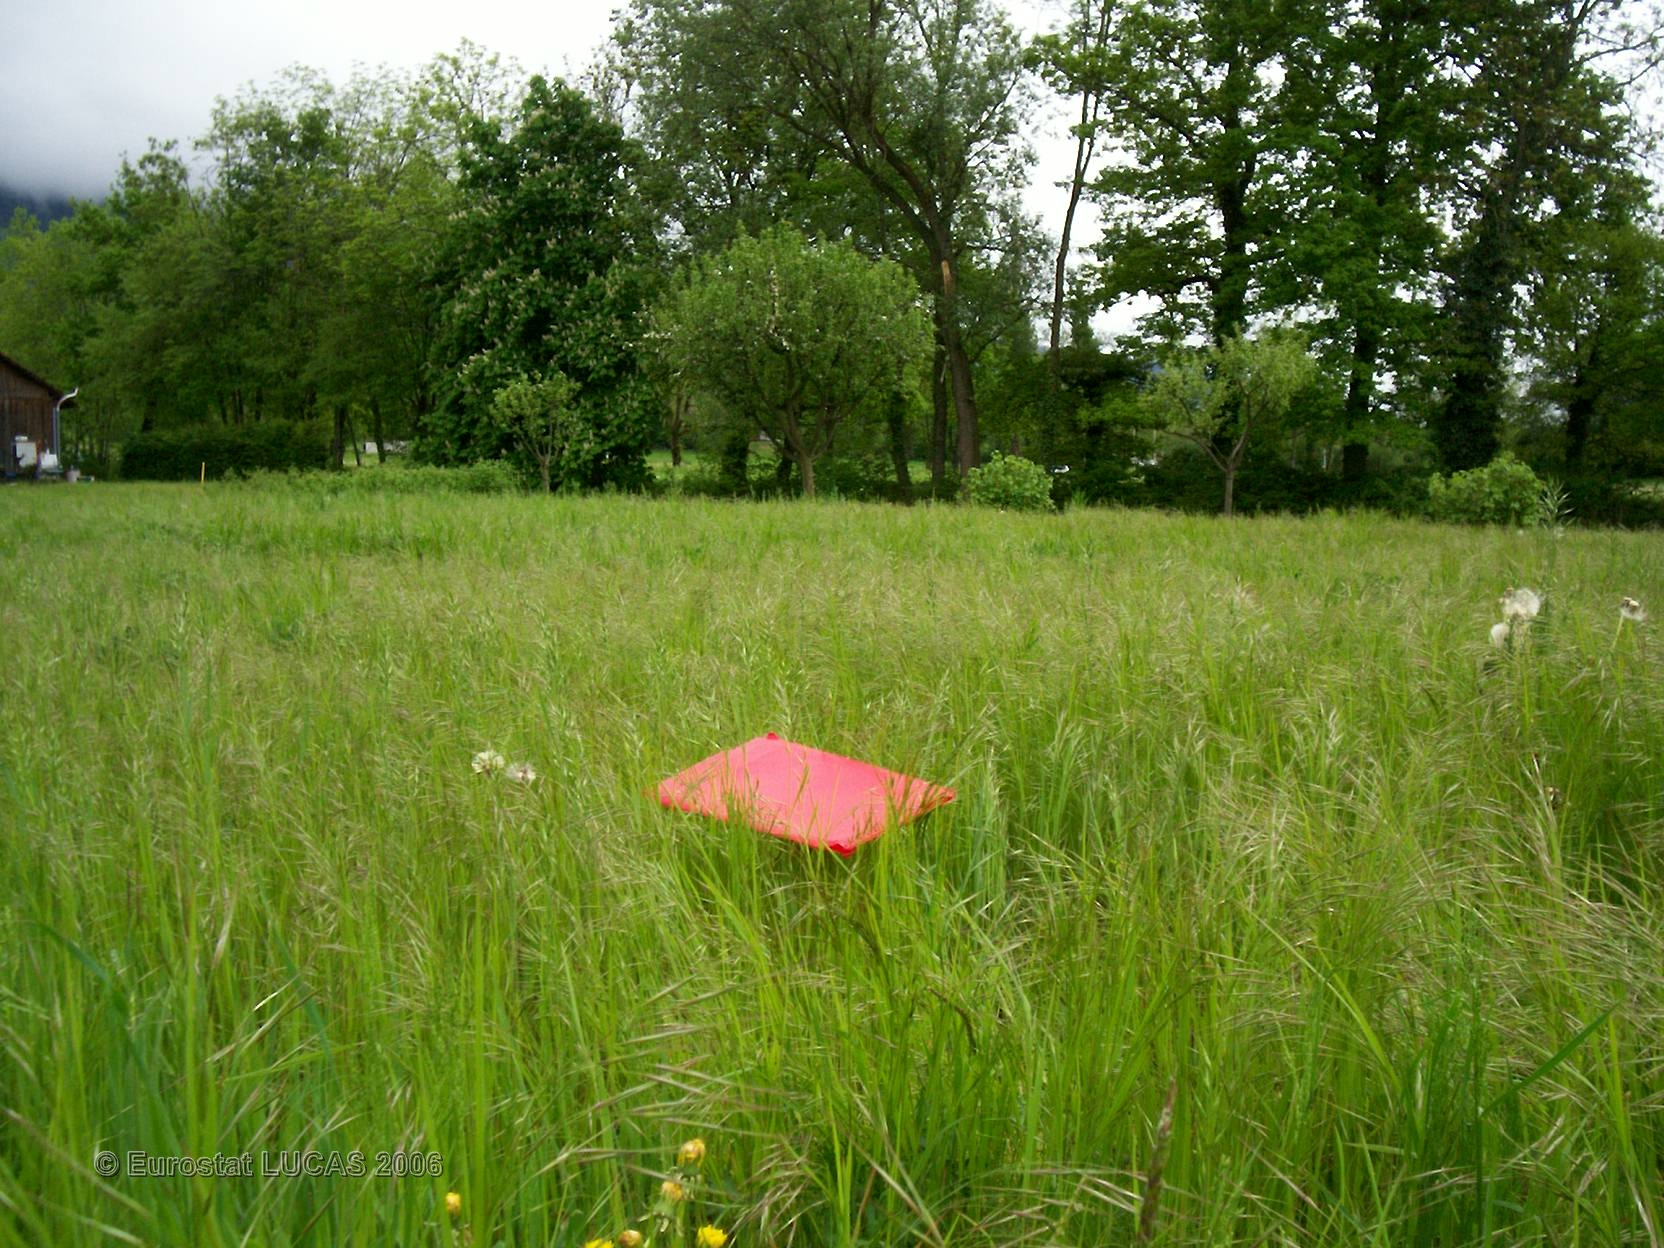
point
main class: Grassland
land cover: Grassland without tree/shrub cover
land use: Agriculture (excluding fallow land and kitchen gardens)
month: May
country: FR
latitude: 46.1181
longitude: 6.1087
